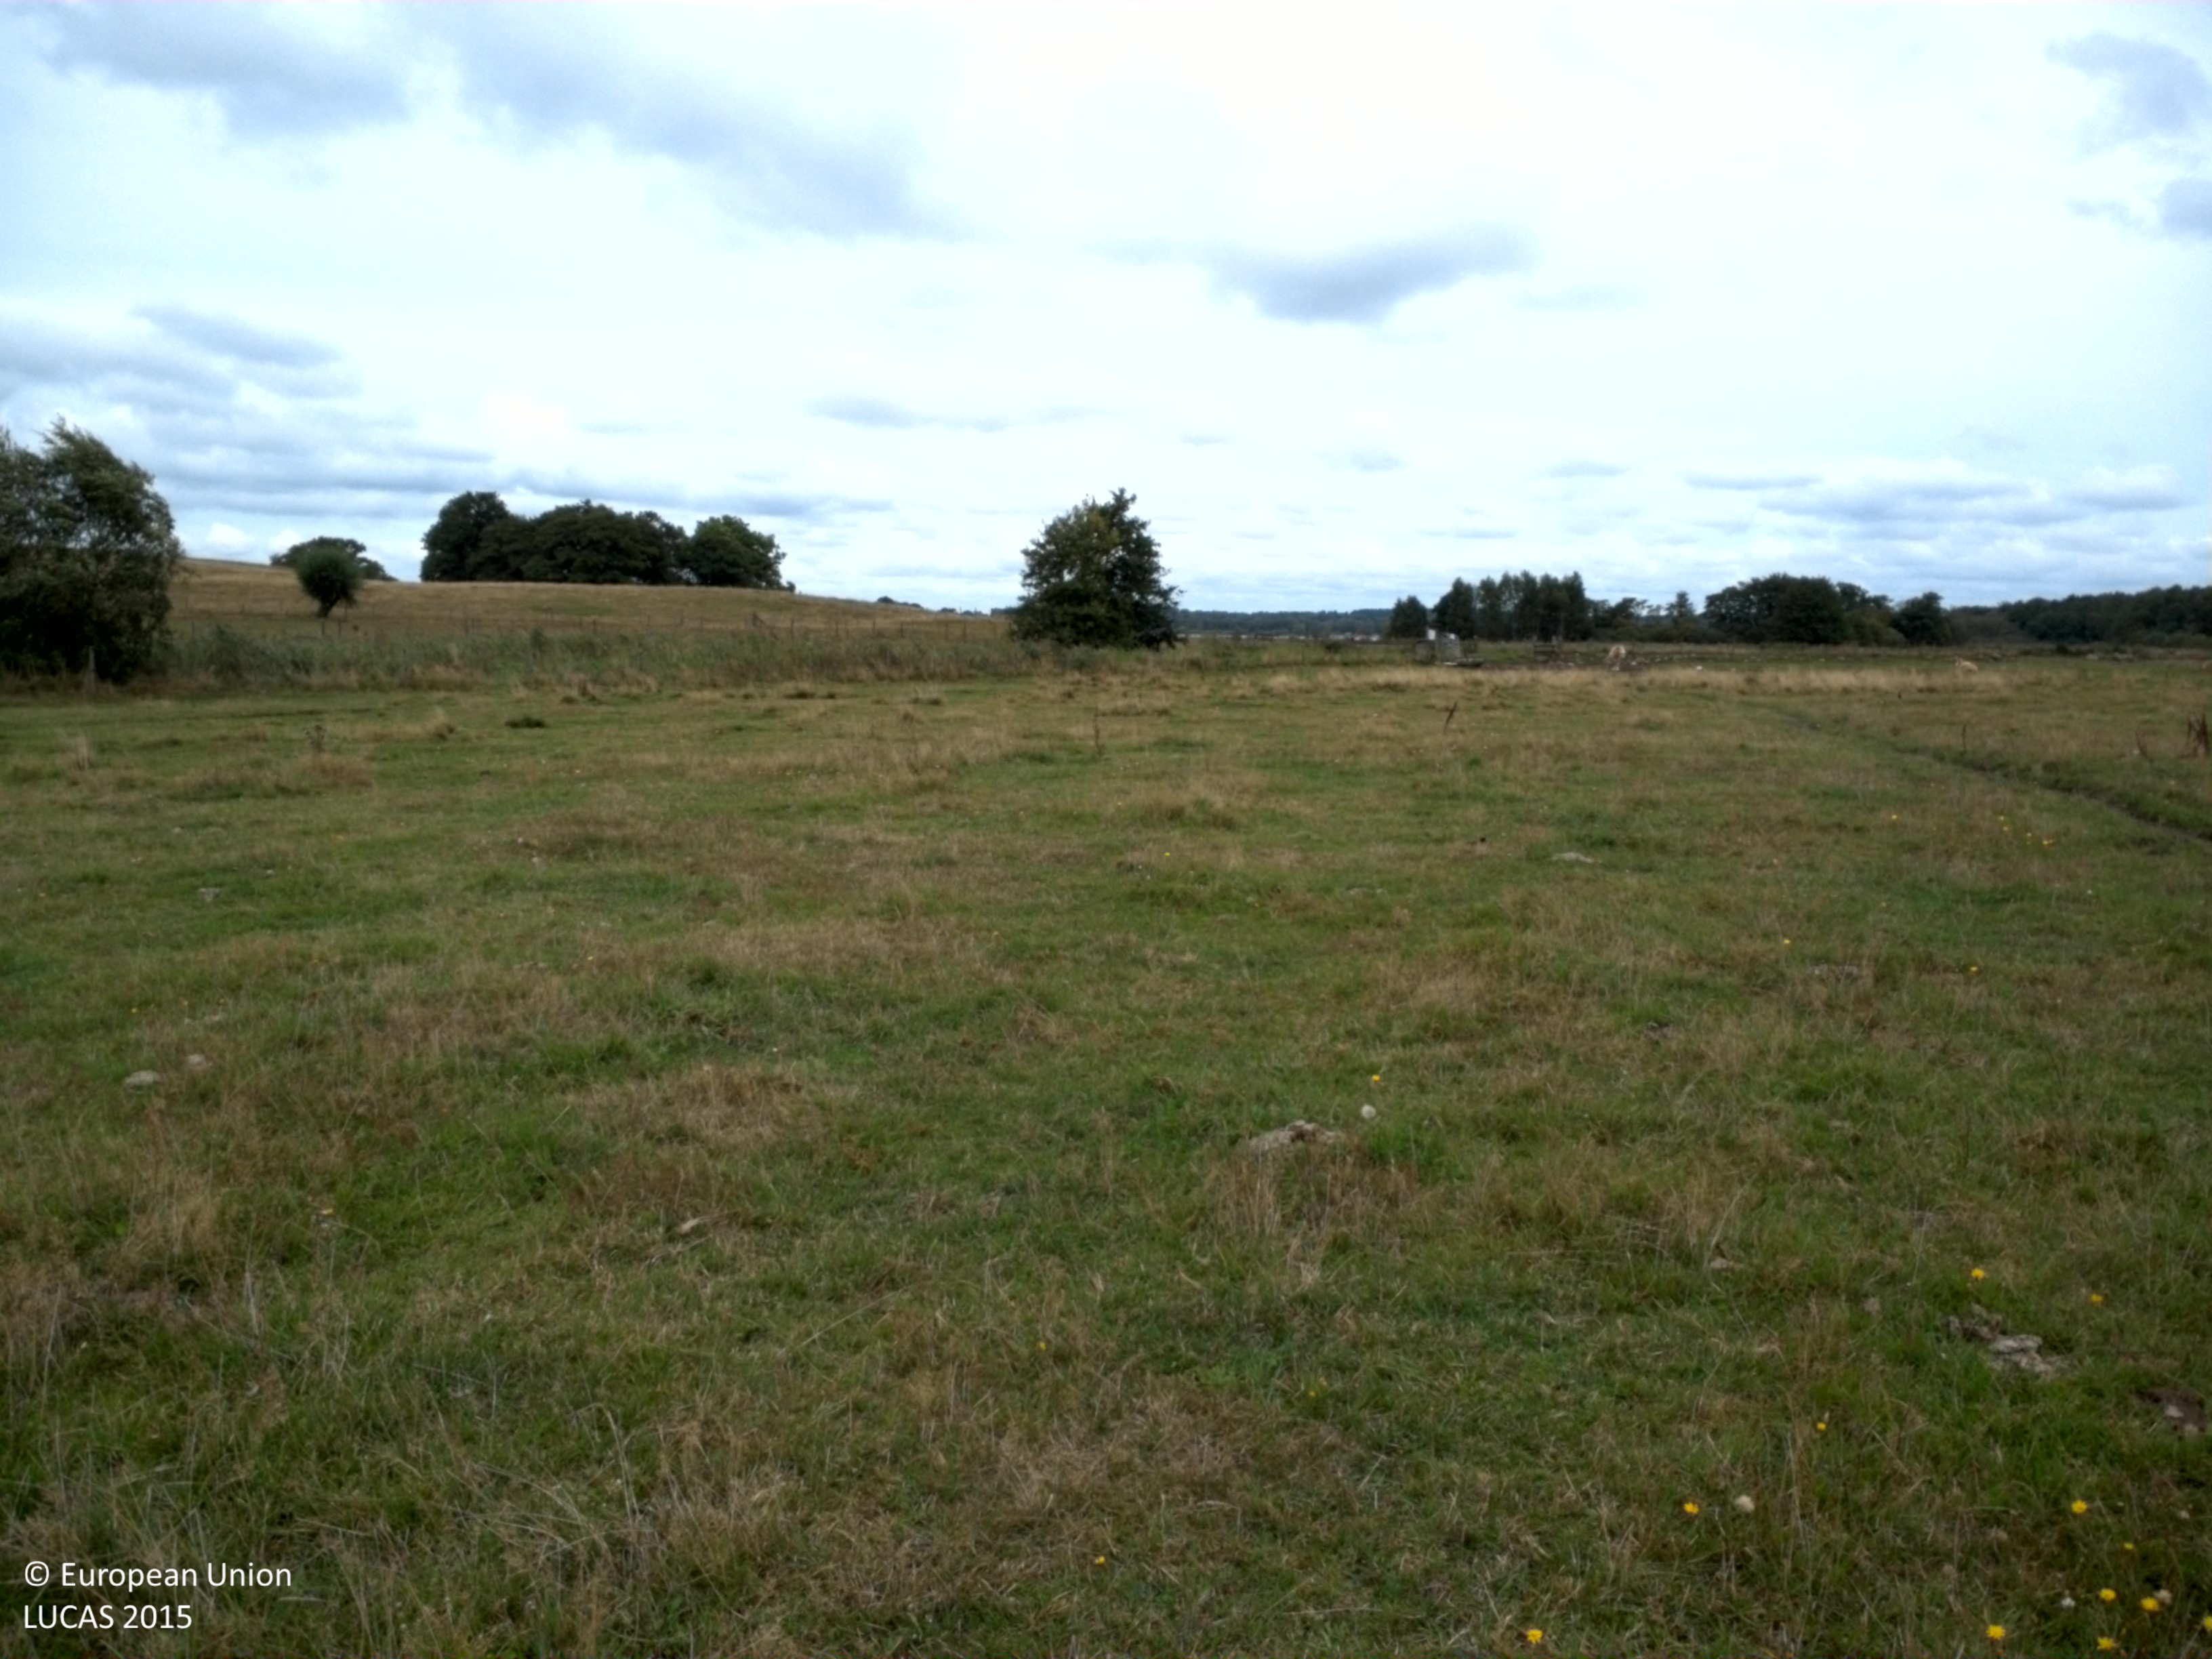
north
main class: Grassland
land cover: Grassland without tree/shrub cover
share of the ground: > 75 %
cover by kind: herbaceous plants 100 %
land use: Agriculture (excluding fallow land and kitchen gardens)
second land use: Amenities, museums, leisure
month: September
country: SE
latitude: 55.5598
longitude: 13.6607
